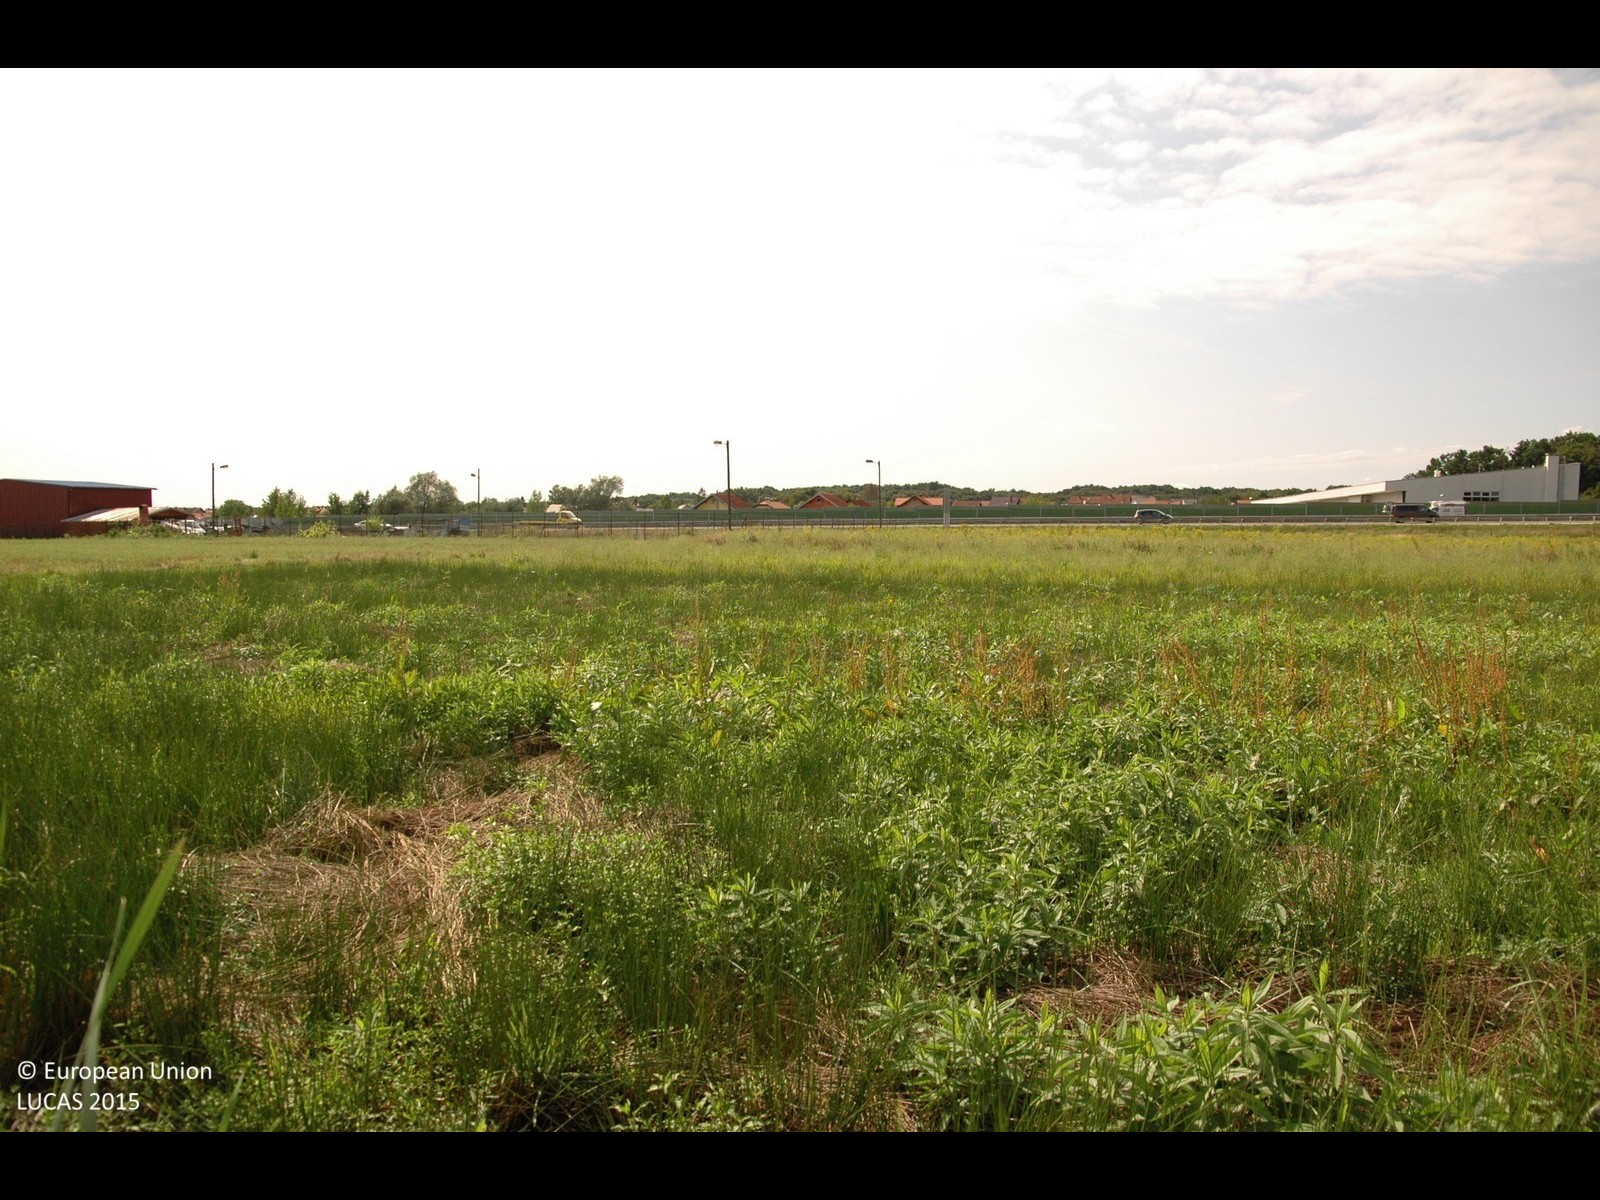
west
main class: Grassland
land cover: Grassland without tree/shrub cover
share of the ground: > 75 %
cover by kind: herbaceous plants 100 %
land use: Agriculture (excluding fallow land and kitchen gardens)
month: August
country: HR
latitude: 45.8317
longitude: 16.1389
